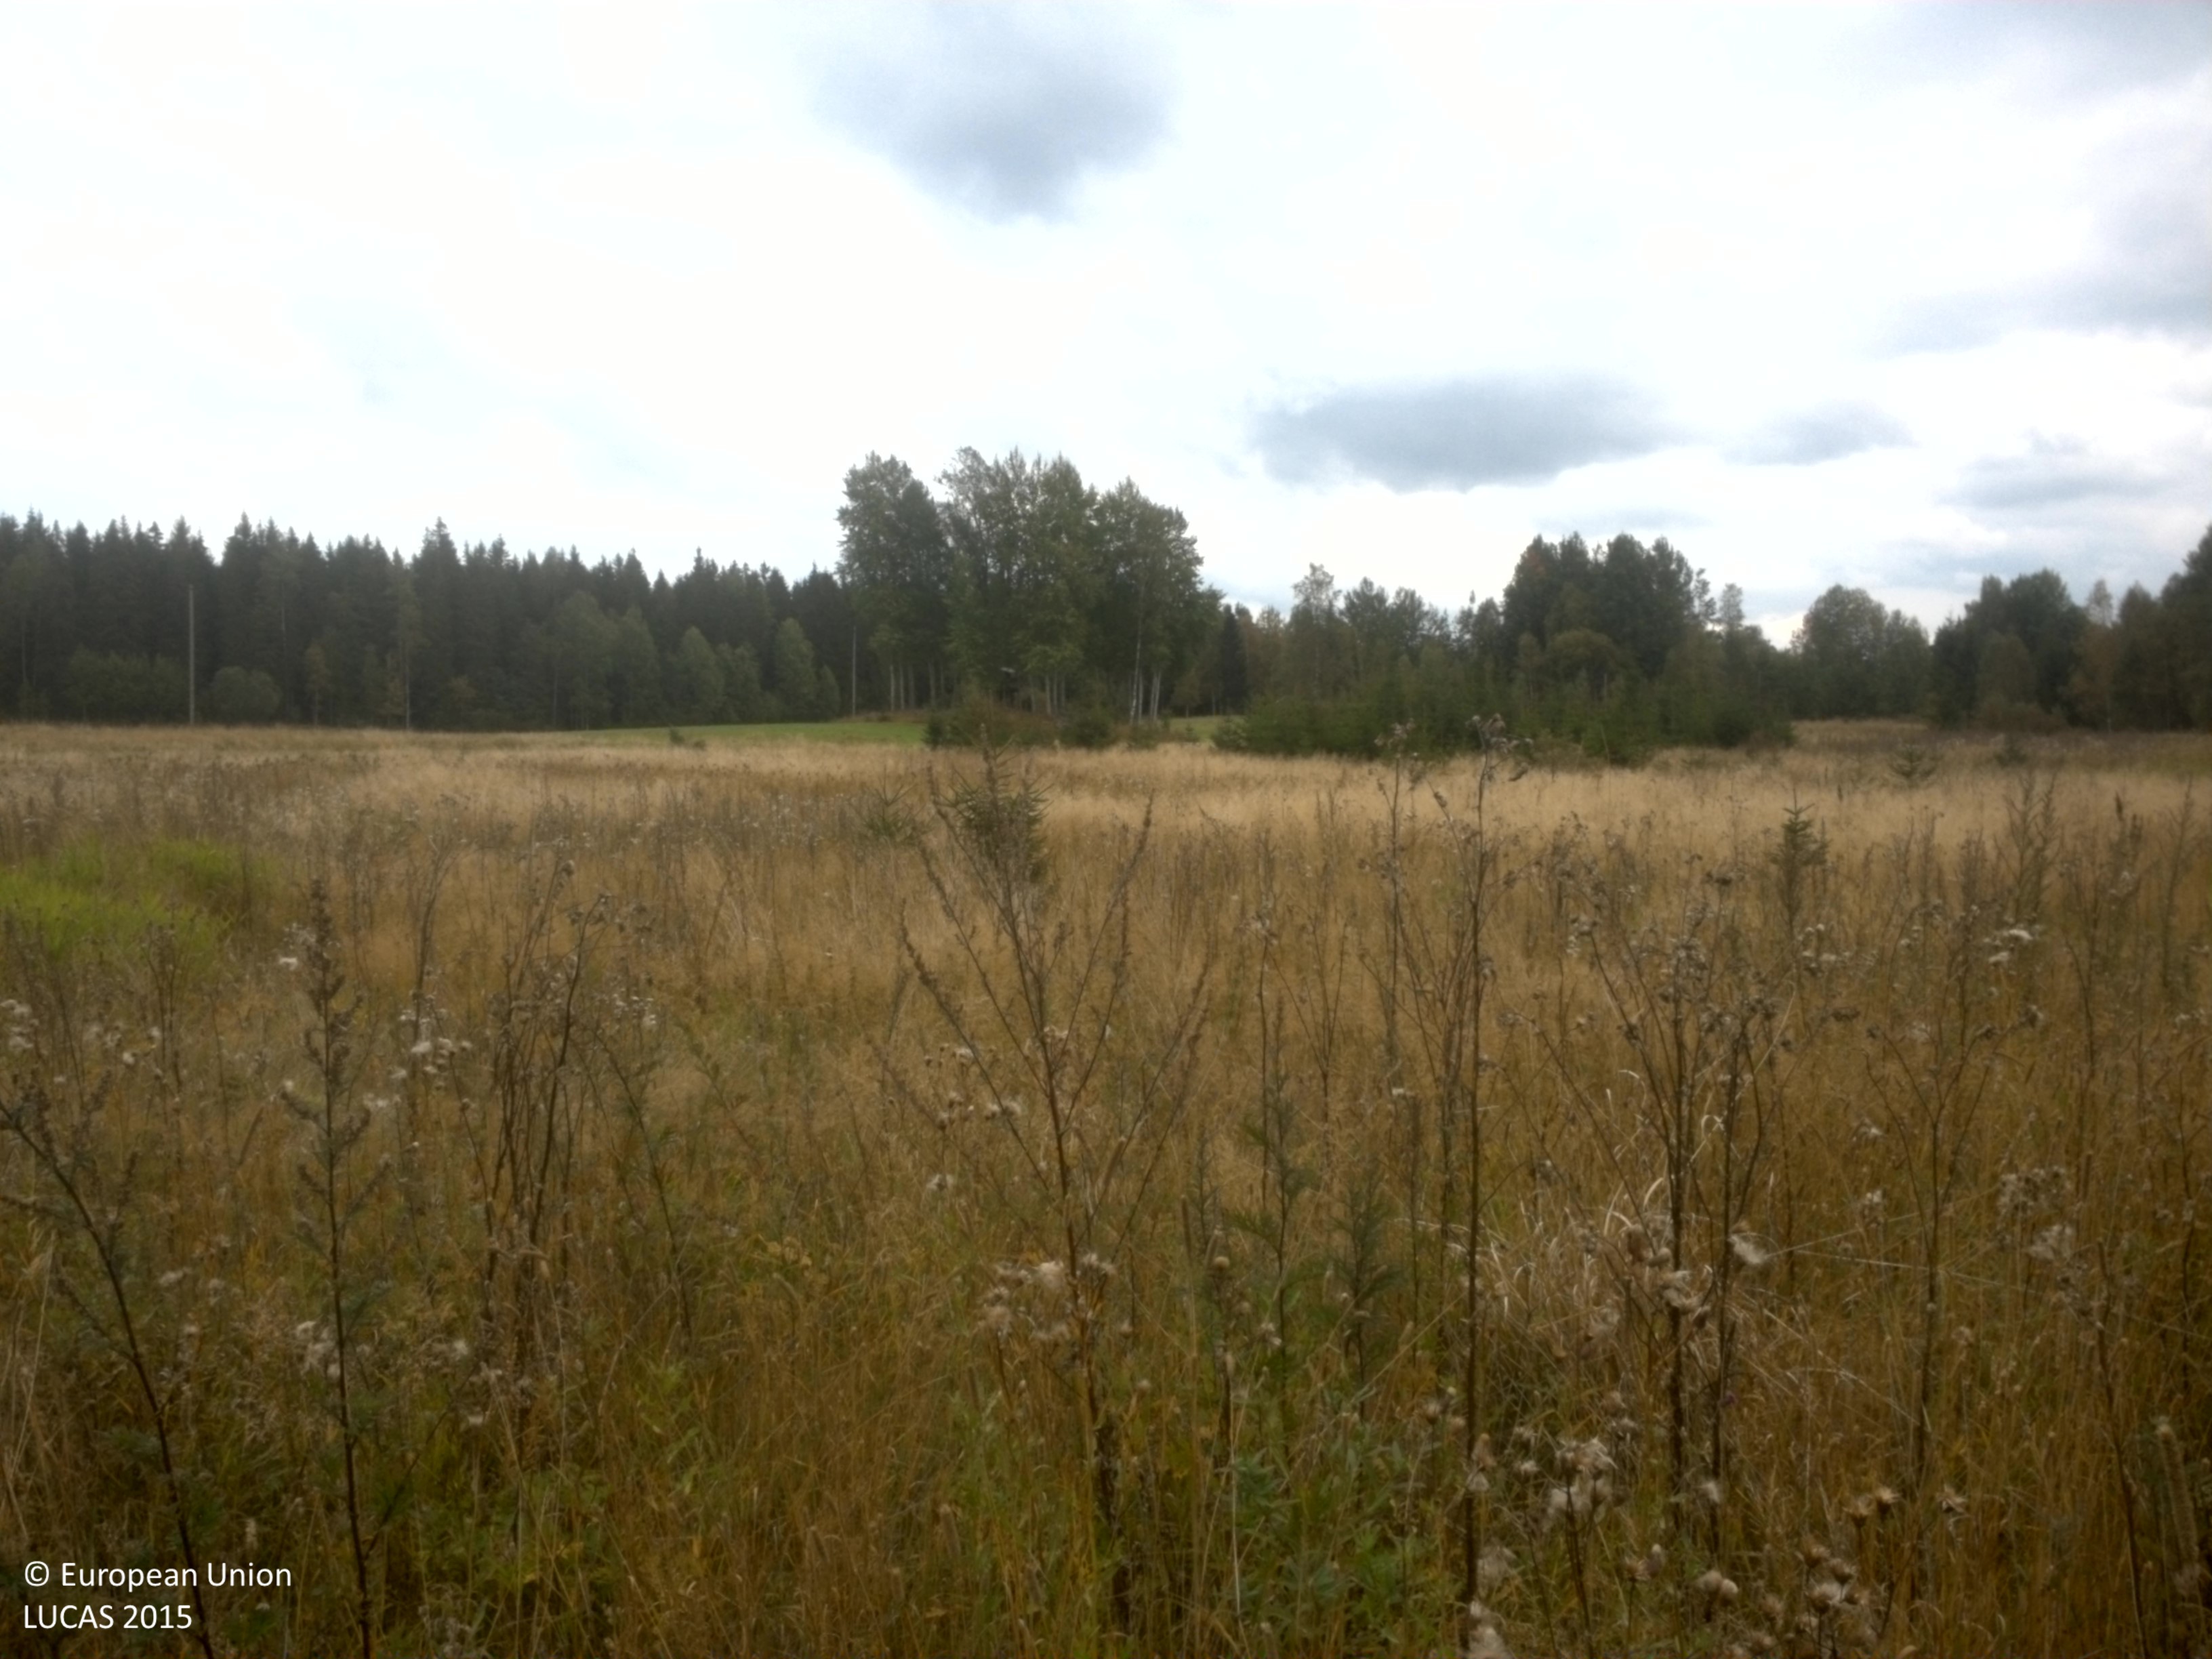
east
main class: Grassland
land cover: Spontaneously vegetated surfaces
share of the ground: > 75 %
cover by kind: herbaceous plants 100 %
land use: Agriculture (excluding fallow land and kitchen gardens)
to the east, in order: Spontaneously vegetated surfaces; Single bushes/trees; Temporary grasslands; Ditches and canals; Temporary grasslands; Groves; Electric lines; Temporary grasslands
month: September
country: SE
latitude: 59.5697
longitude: 15.4604
